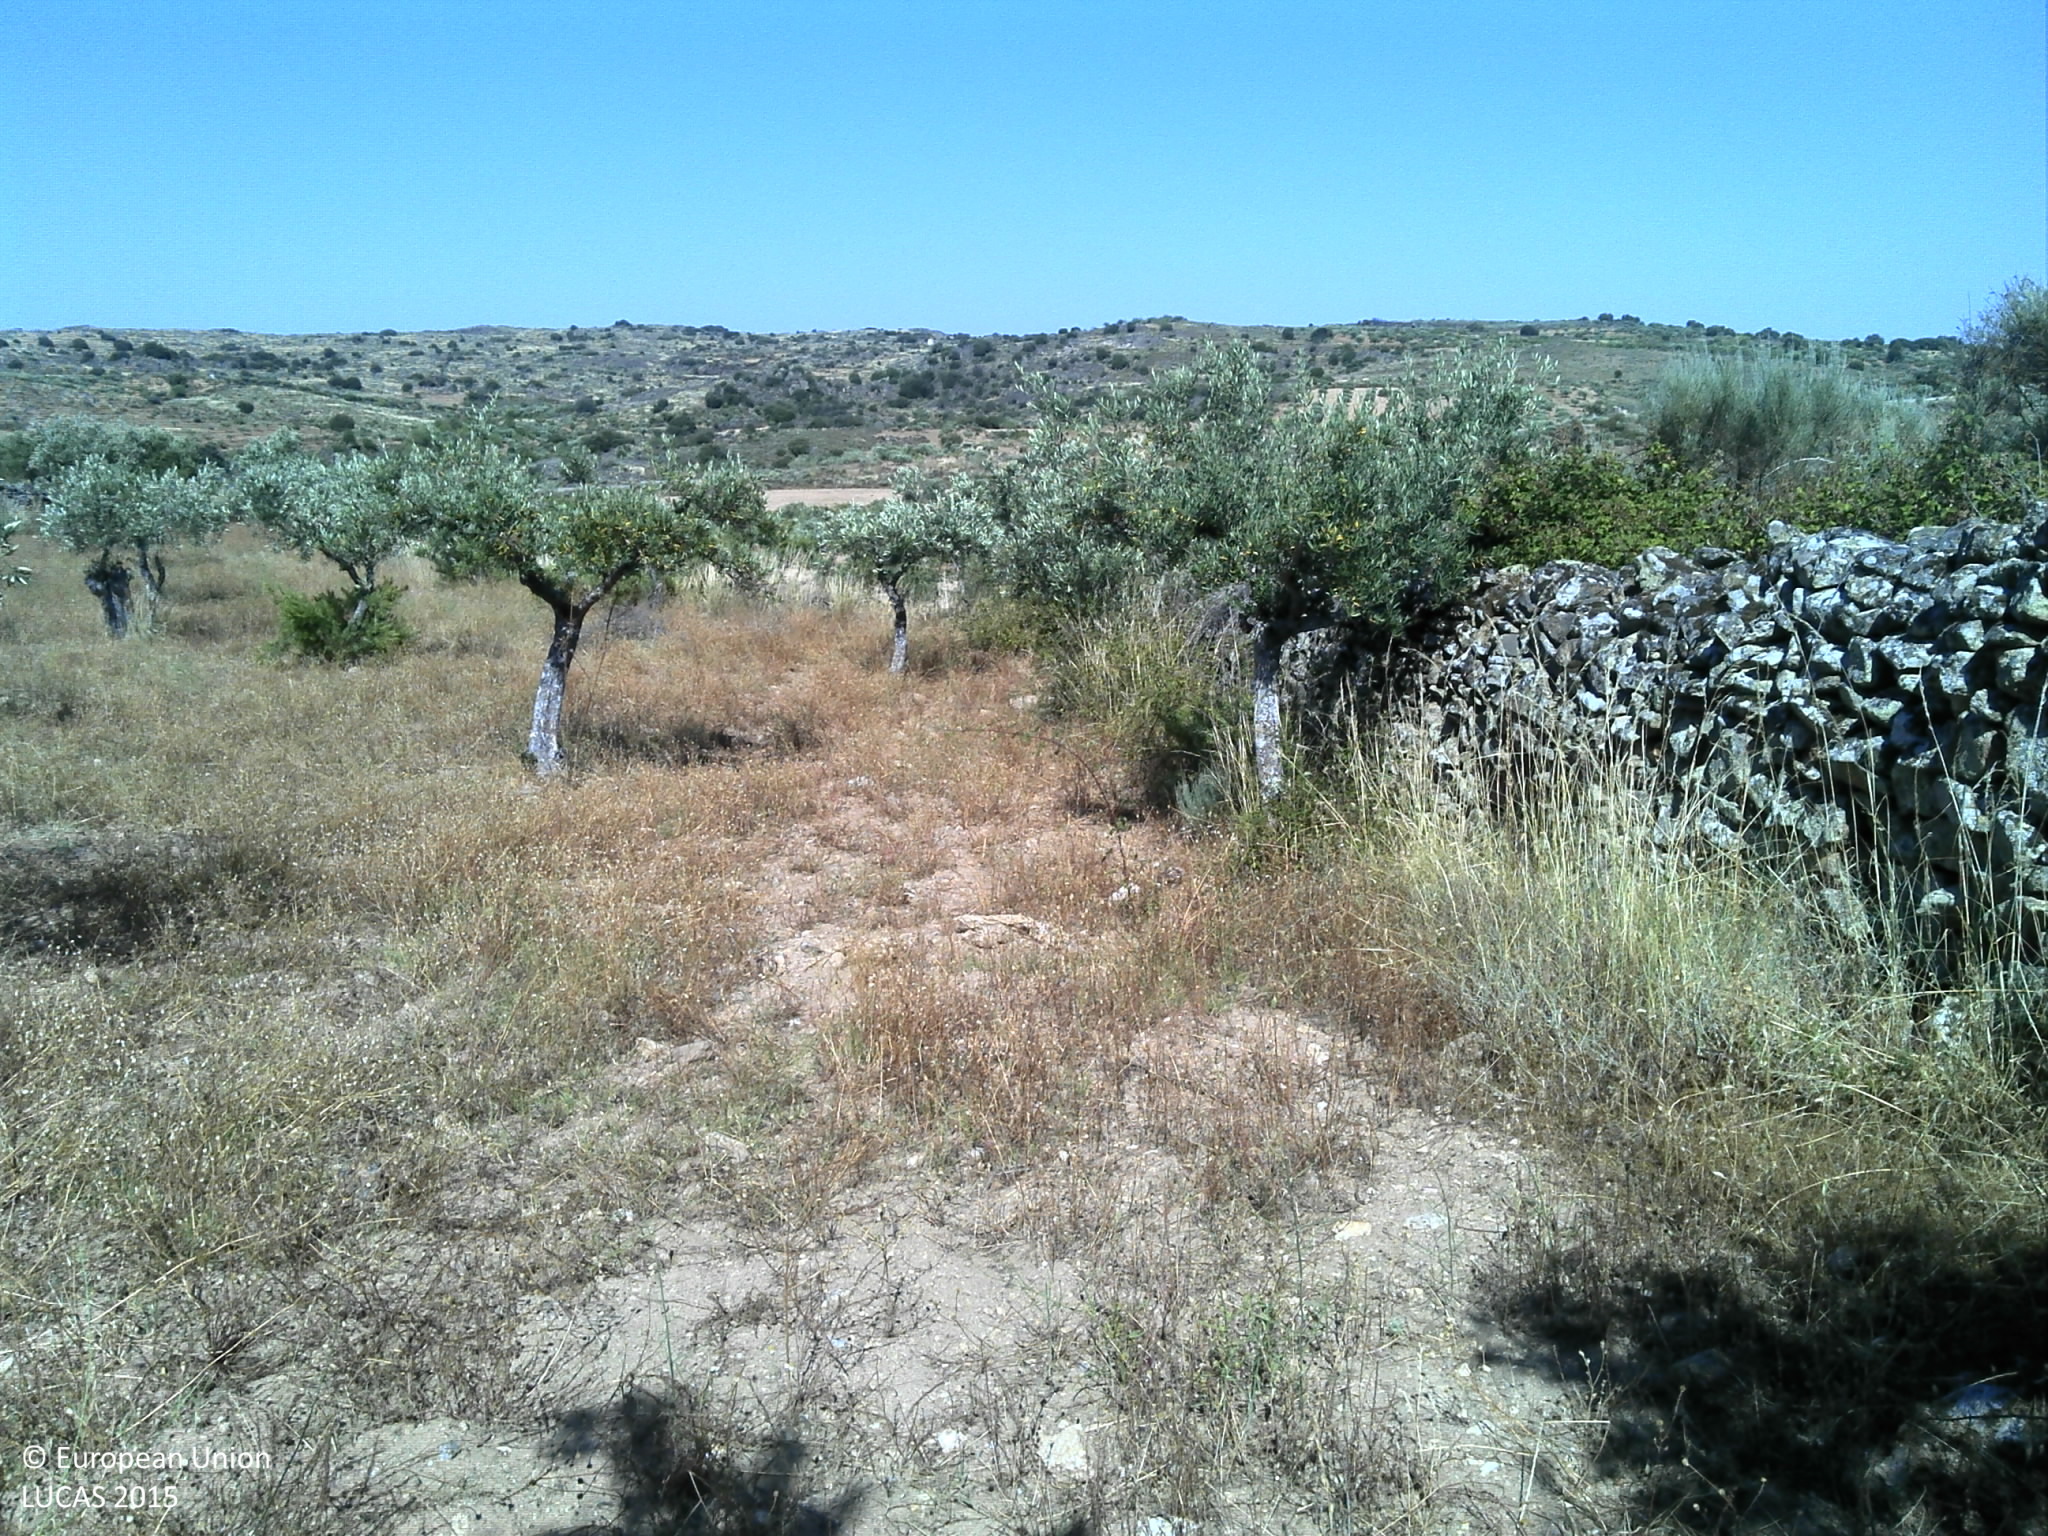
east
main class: Cropland
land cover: Olive groves
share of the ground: 10 - 25 %
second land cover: Spontaneously vegetated surfaces
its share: 25 - 50 %
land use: Agriculture (excluding fallow land and kitchen gardens)
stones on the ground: 10 - 25 %
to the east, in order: Olive groves; Spontaneously vegetated surfaces; Dry stone walls; Shruby margins; Olive groves; Other fruit trees and berries; Shruby margins; Dry stone walls; Other fruit trees and berries; Olive groves; Dry stone walls; Shruby margins; Nuts trees; Olive groves; Dry stone walls; Shruby margins; Olive groves
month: June
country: PT
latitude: 40.9679
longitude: -7.0889
